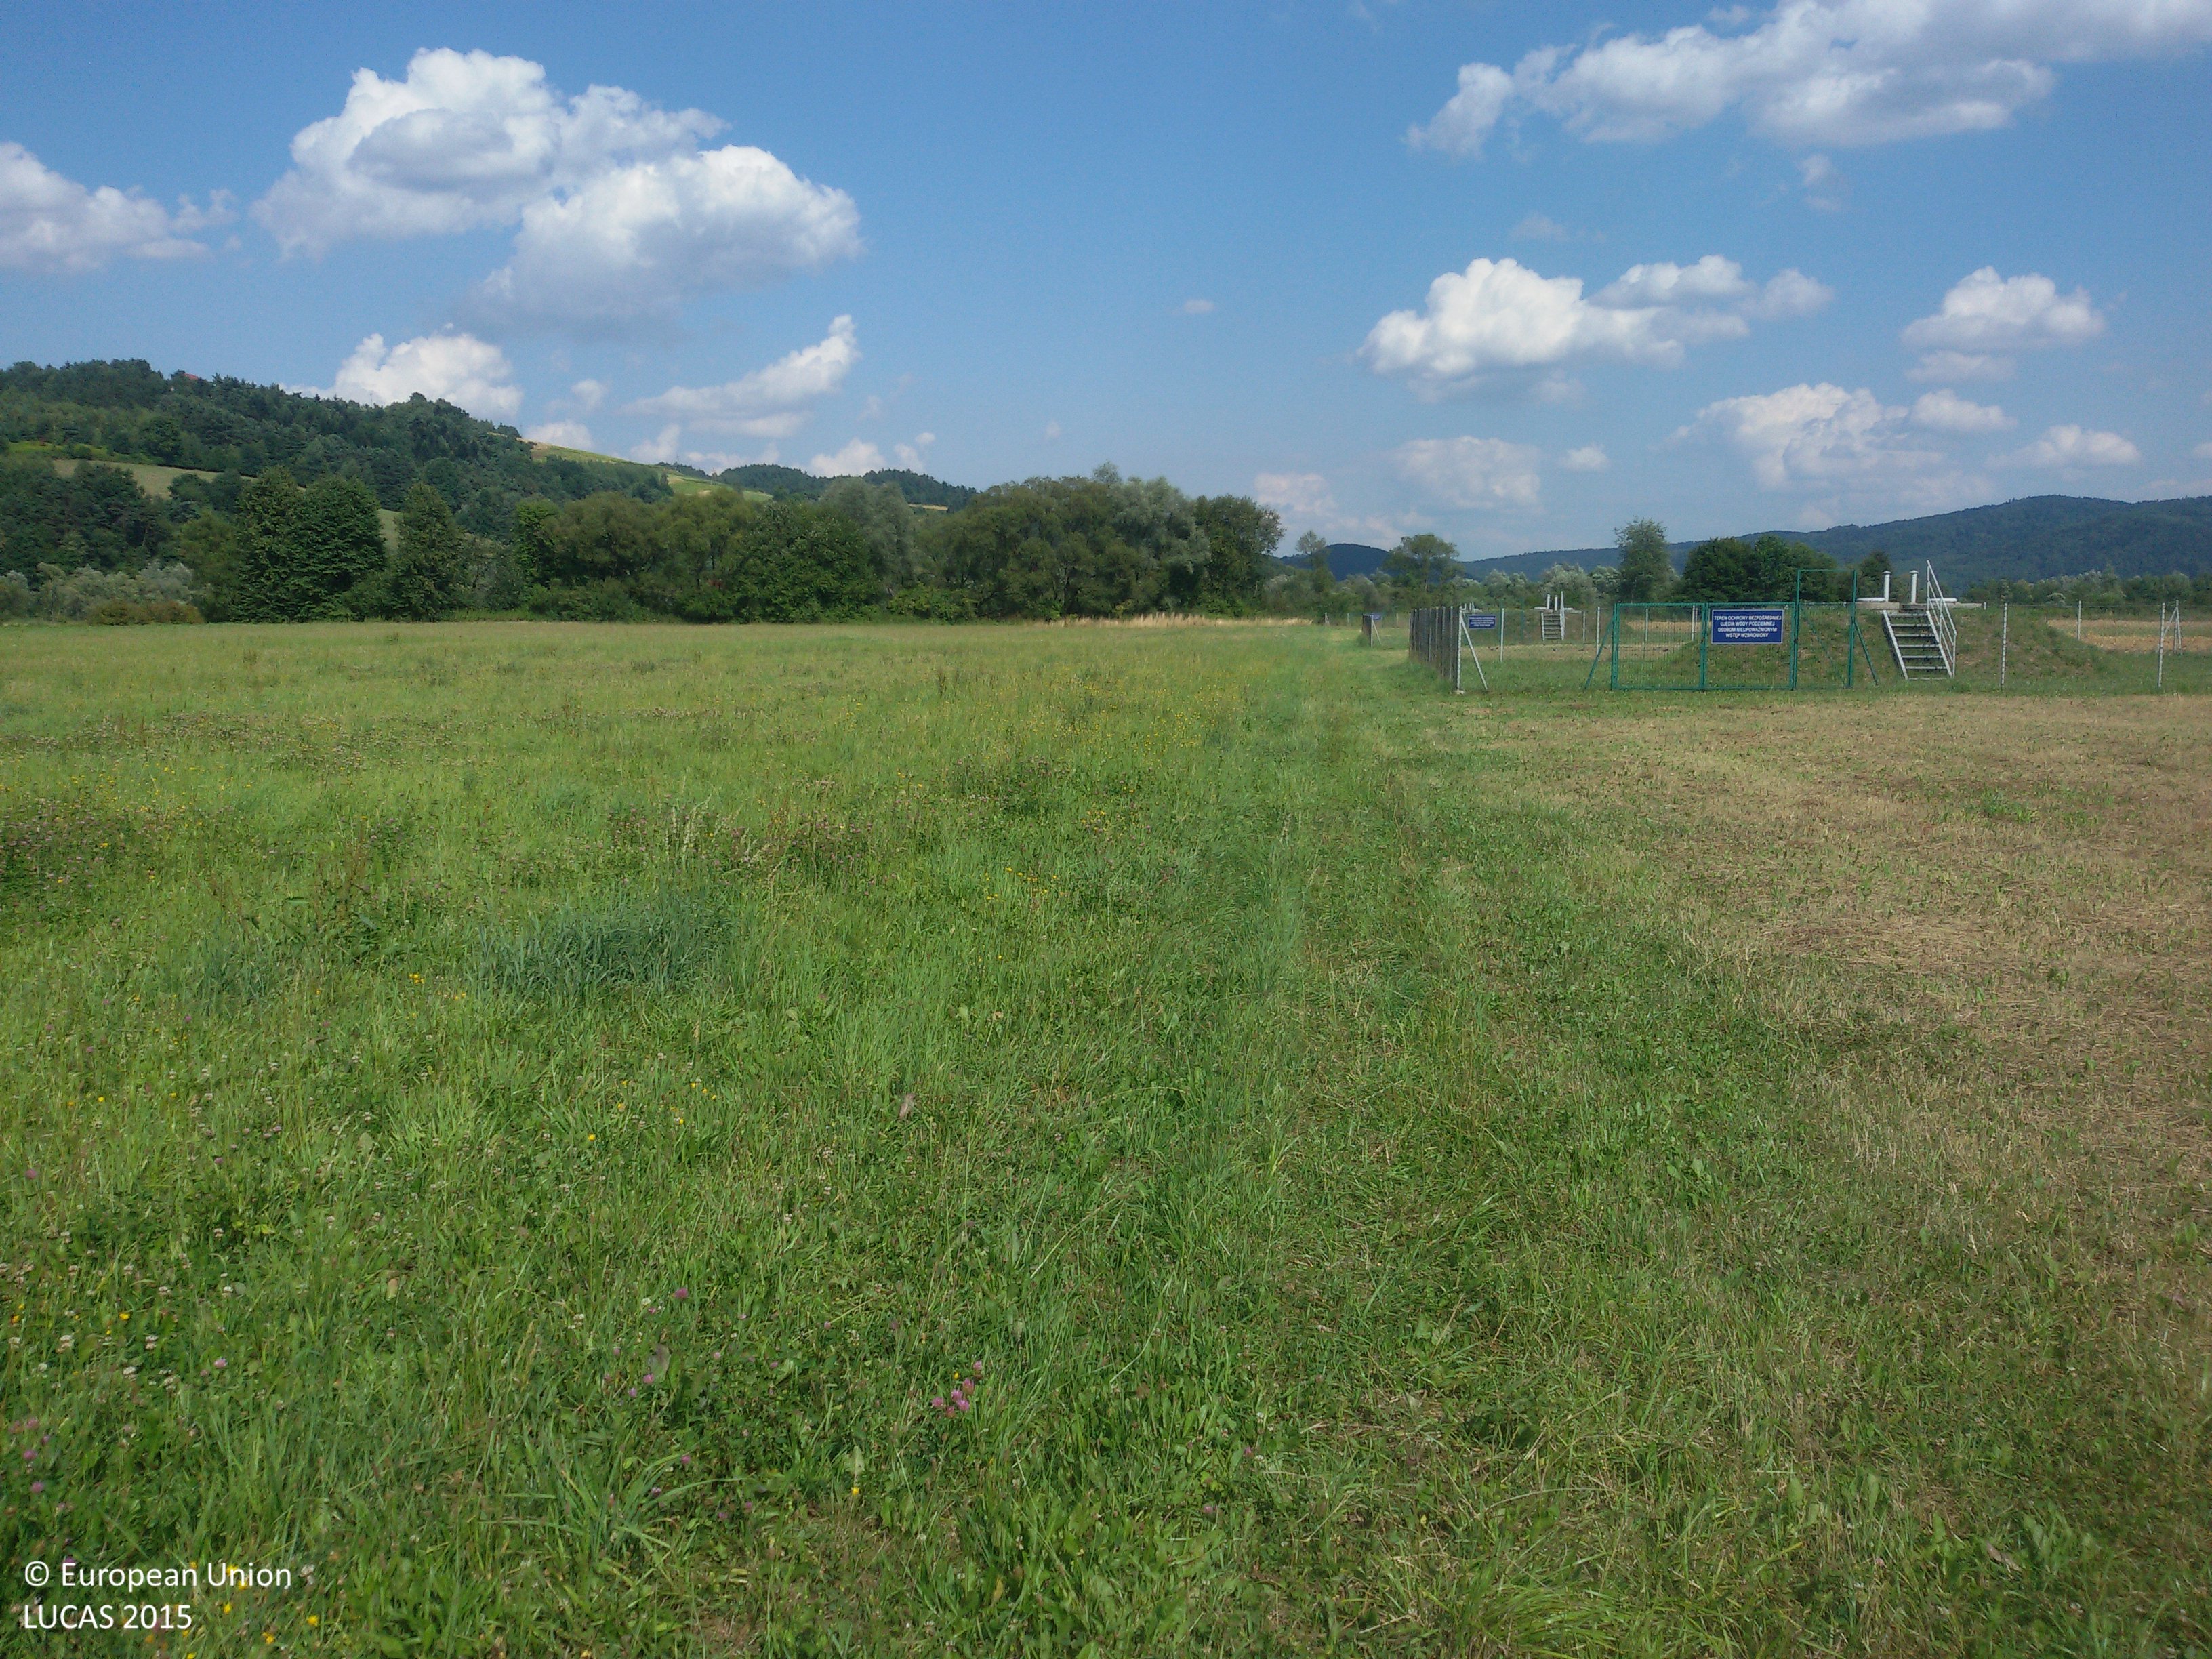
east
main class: Grassland
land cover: Grassland without tree/shrub cover
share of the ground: > 75 %
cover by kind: herbaceous plants 100 %
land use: Water supply and treatment
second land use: Agriculture (excluding fallow land and kitchen gardens)
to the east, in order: Grassland without tree/shrub cover; Artificial constructions in urban areas; Grassland without tree/shrub cover; Artificial constructions in urban areas; Grassland without tree/shrub cover; Artificial constructions in urban areas; Shrubland with sparse tree cover; Inland fresh running water
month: July
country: PL
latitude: 49.7913
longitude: 20.6658
